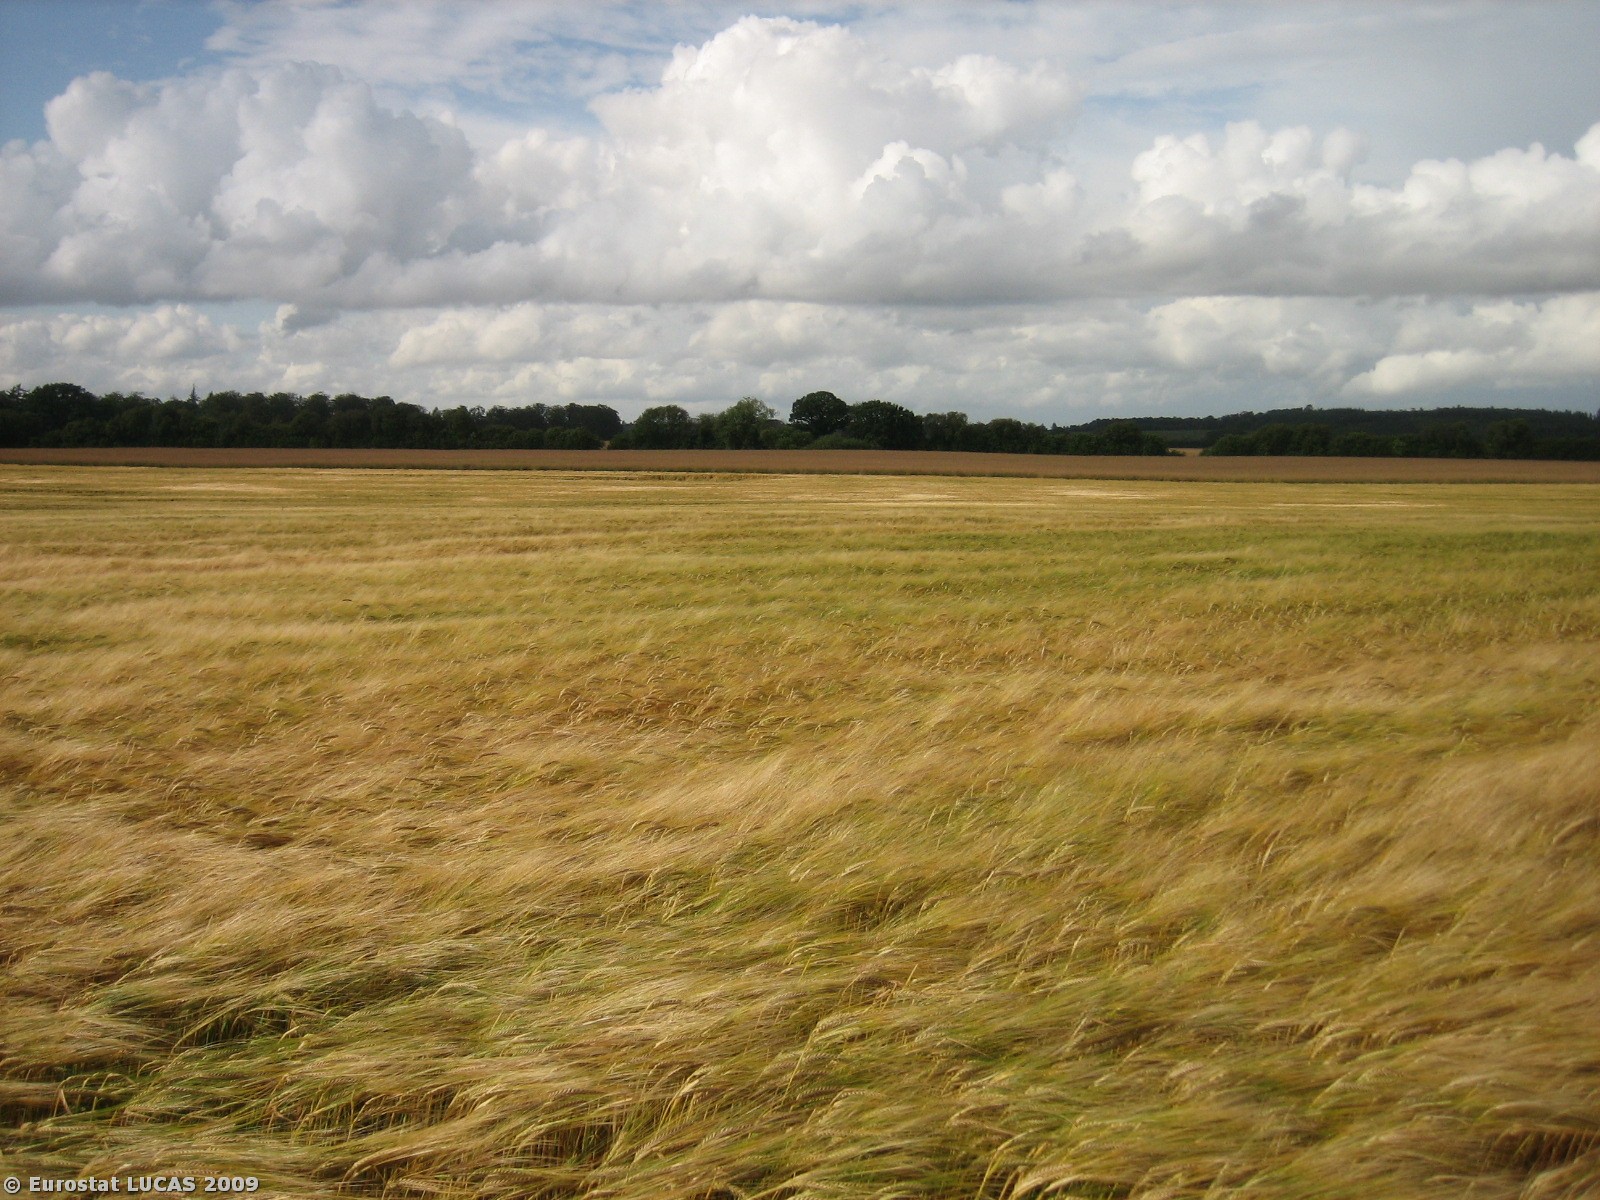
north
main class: Cropland
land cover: Barley
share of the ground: > 75 %
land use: Agriculture (excluding fallow land and kitchen gardens)
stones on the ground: < 10 %
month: July
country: DK
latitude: 55.3968
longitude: 9.8580
